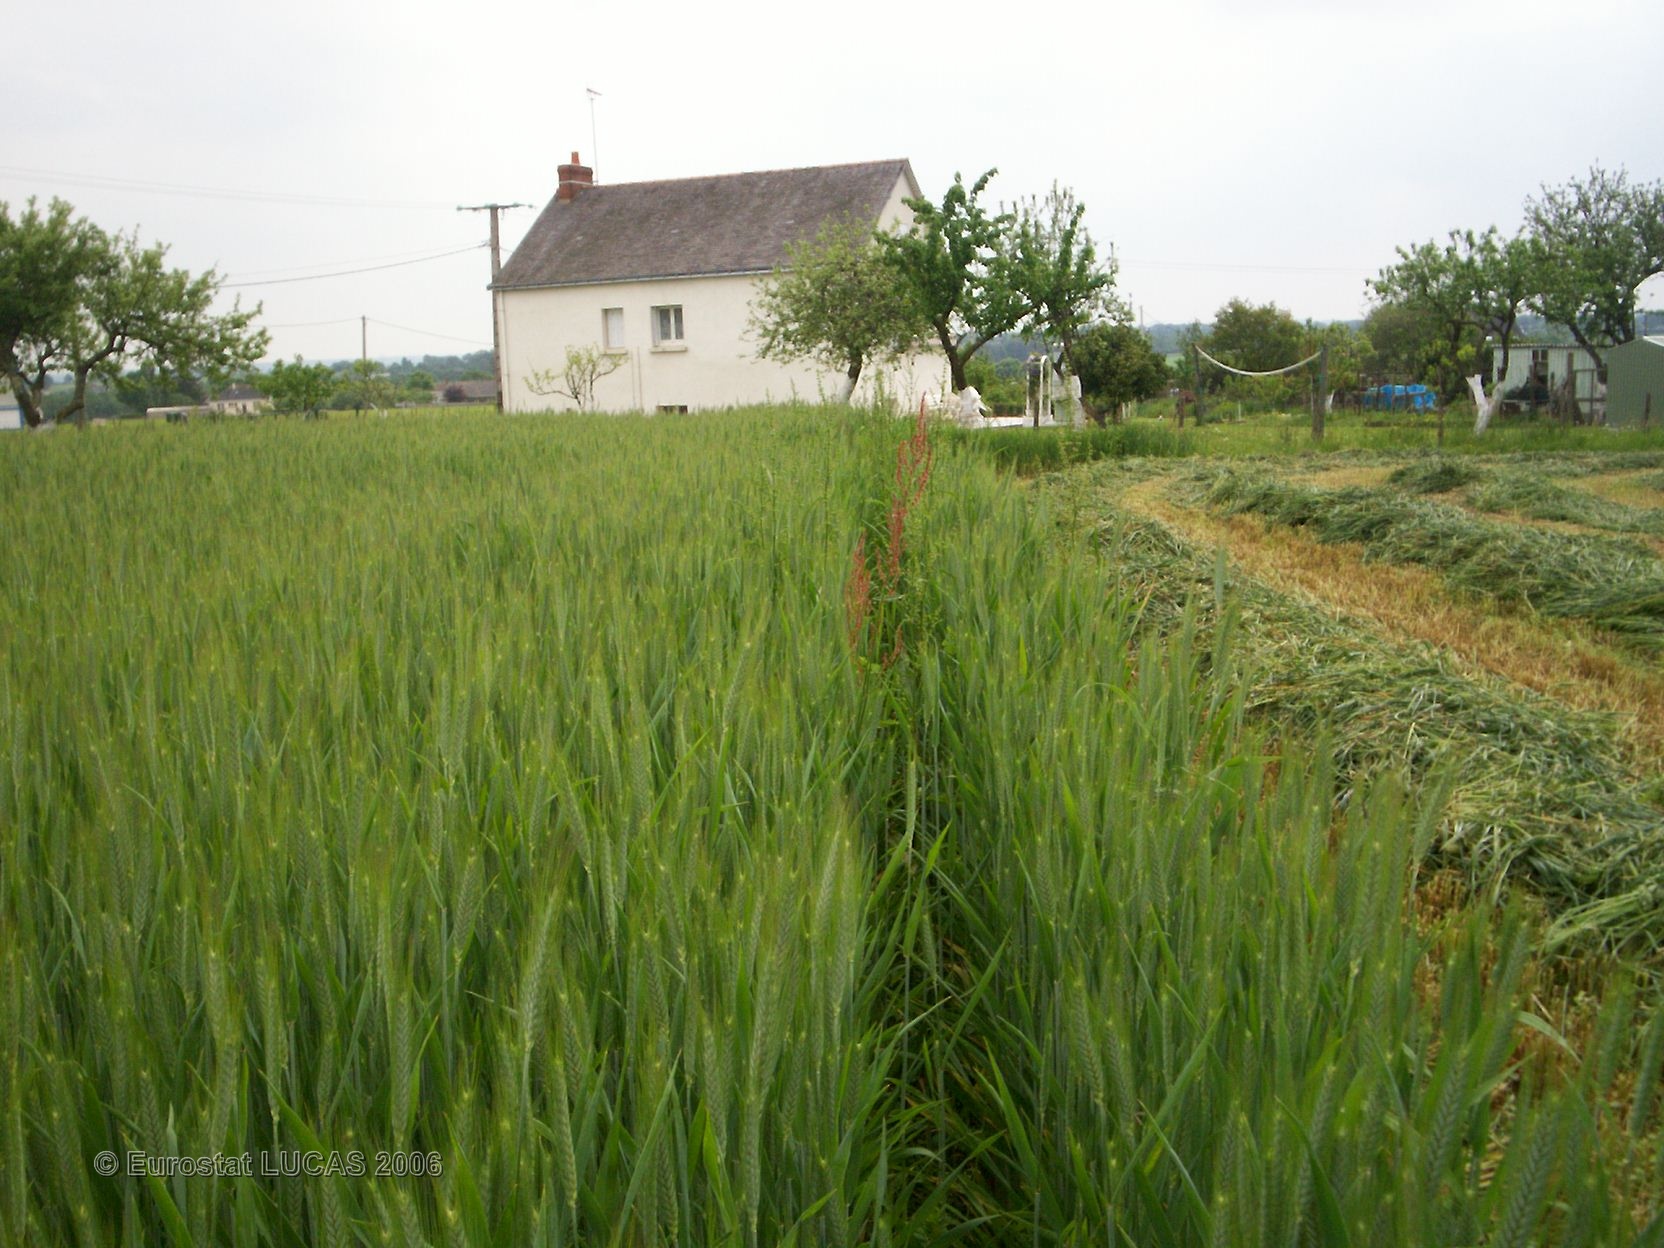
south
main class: Cropland
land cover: Common wheat
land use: Agriculture (excluding fallow land and kitchen gardens)
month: May
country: FR
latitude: 47.6551
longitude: -1.5073
